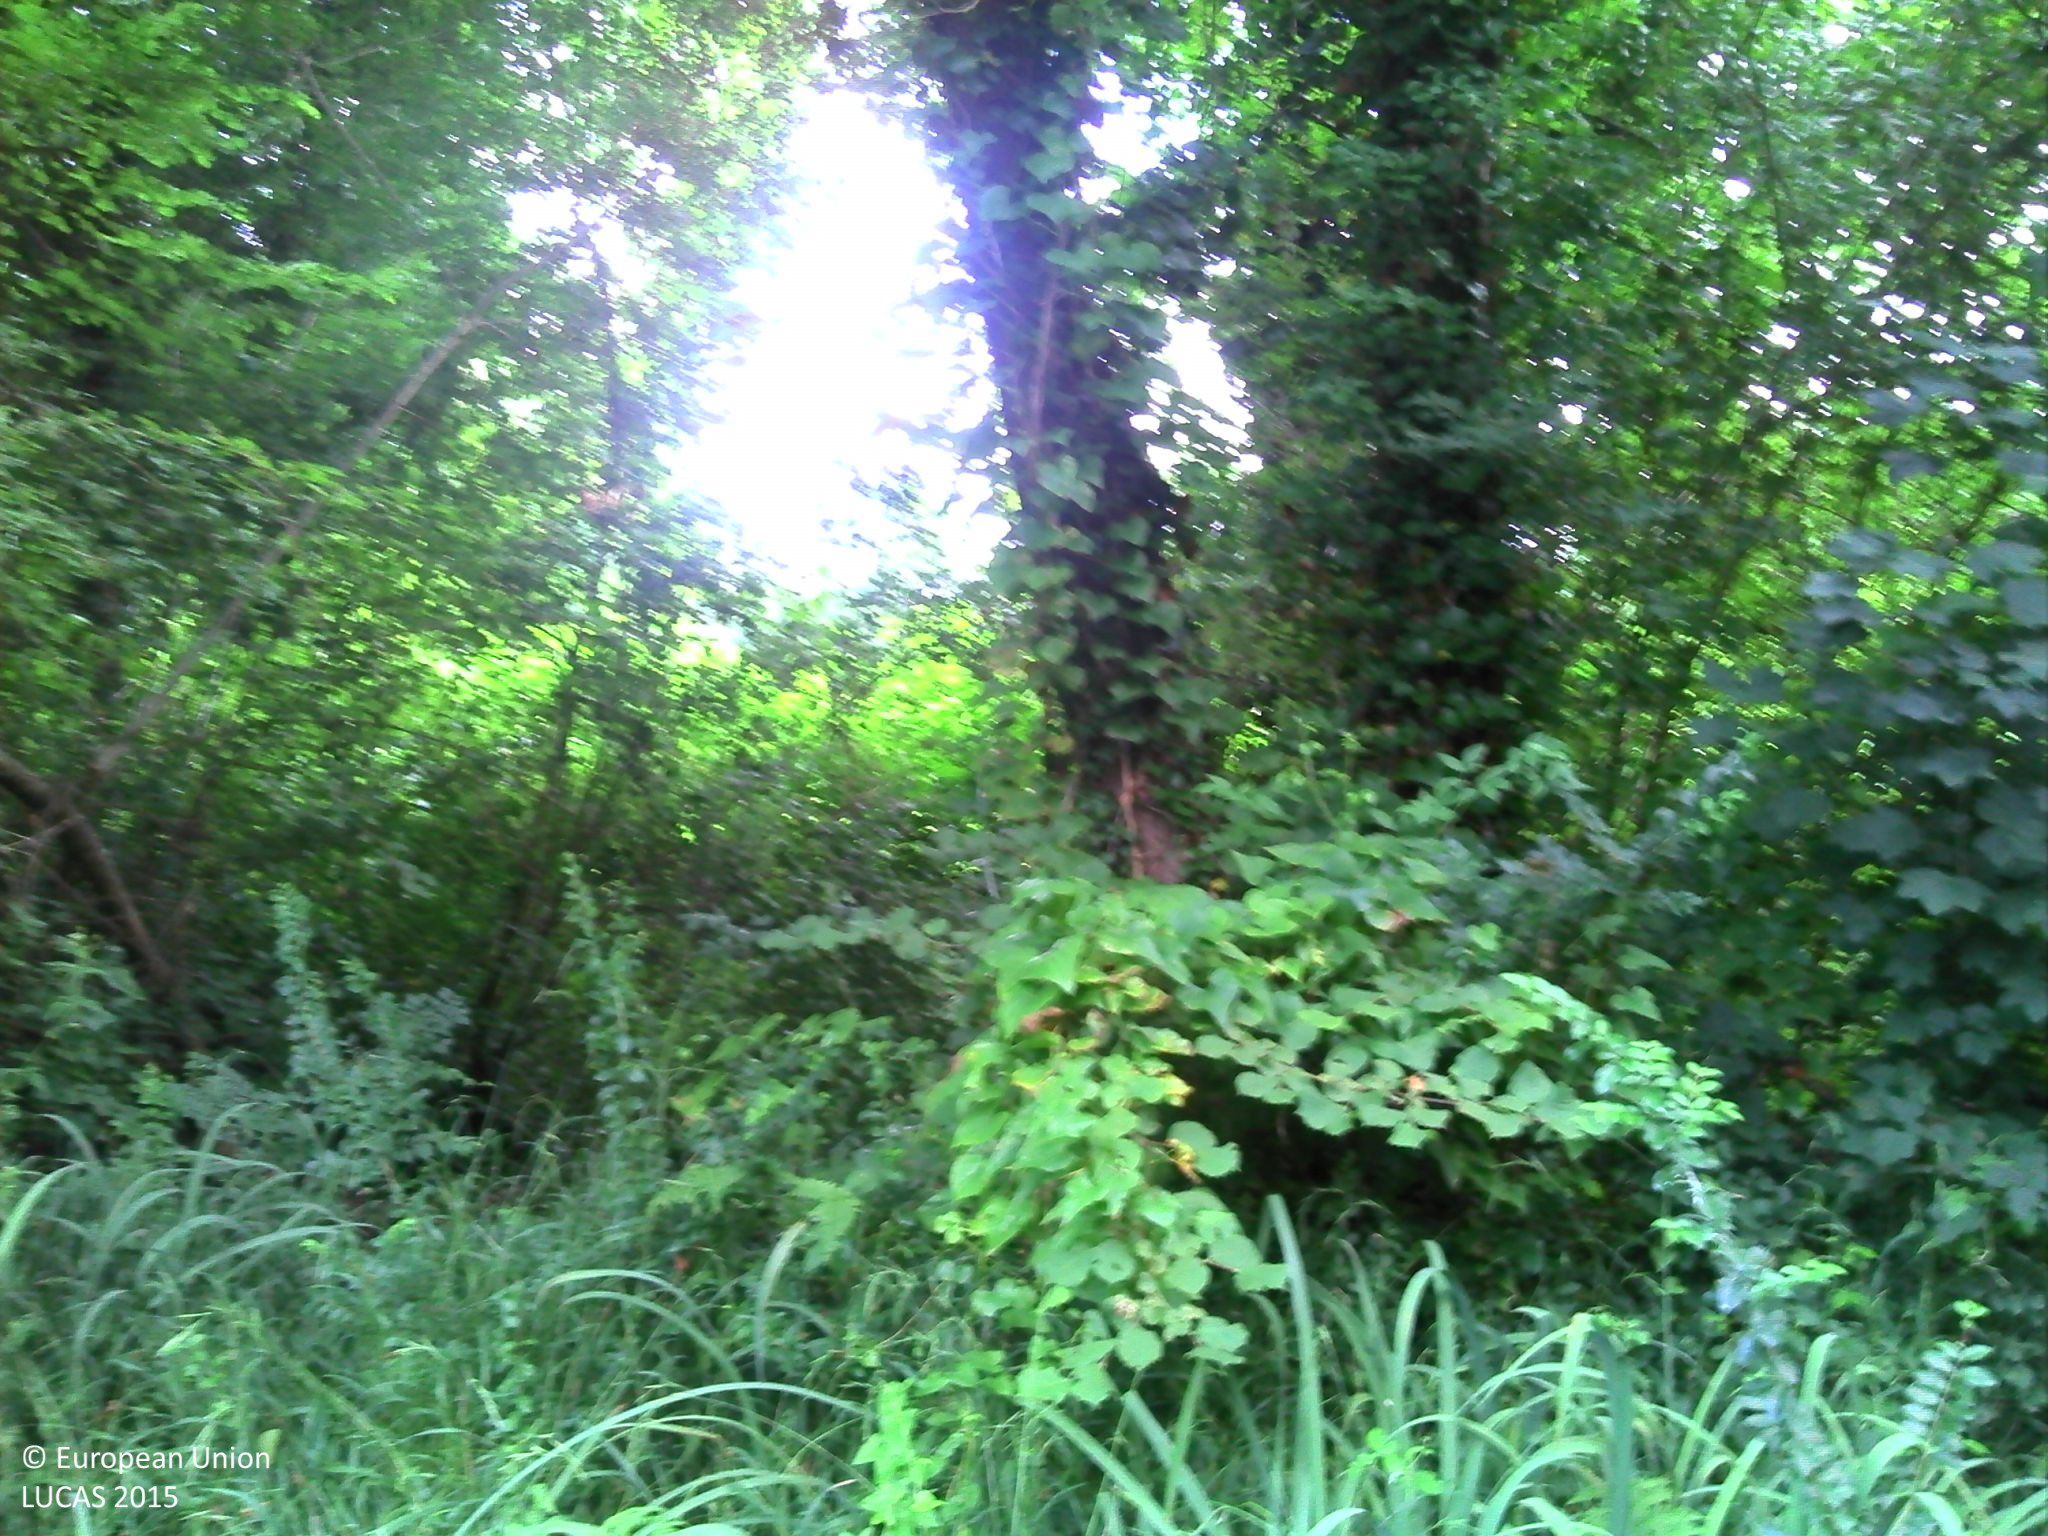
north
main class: Woodland
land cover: Broadleaved woodland
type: mesophytic deciduous forest
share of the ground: > 75 %
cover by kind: broadleaved forest trees 75 %, herbaceous plants 25 %
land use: Forestry
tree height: > 5 m
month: July
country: FR
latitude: 43.8400
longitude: -0.7975
